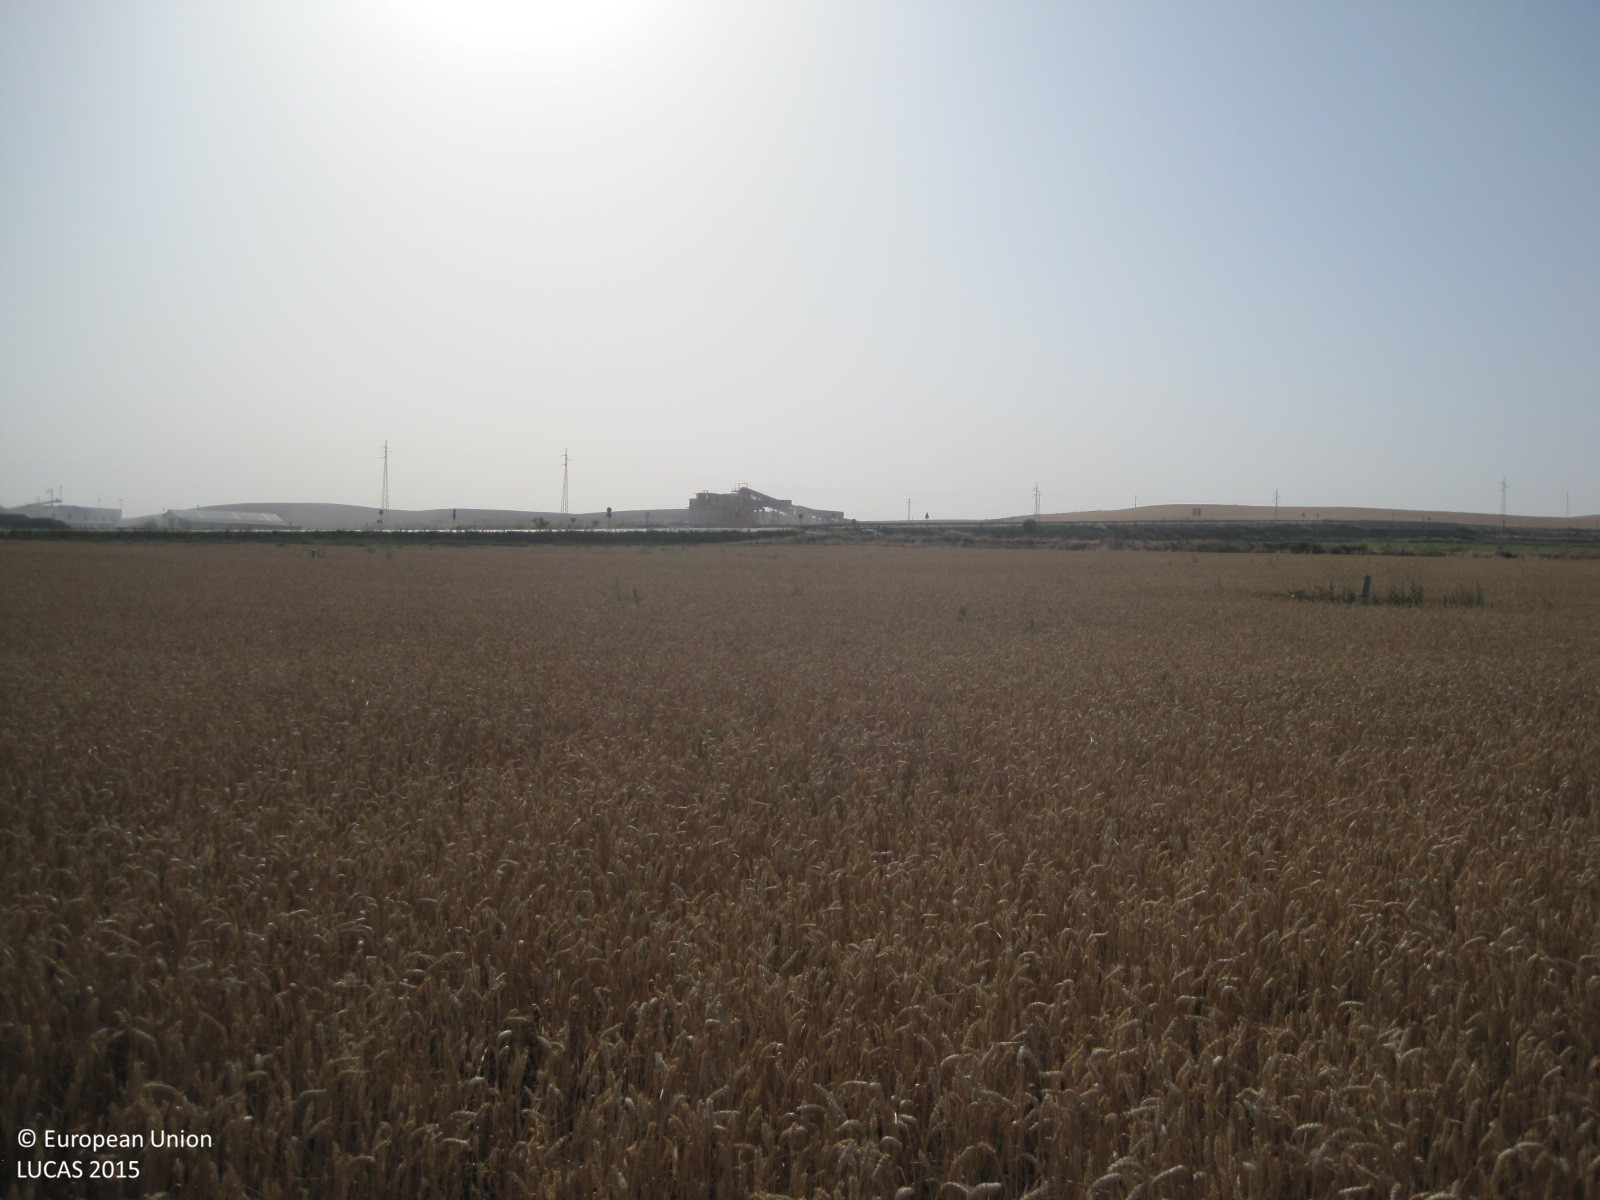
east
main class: Cropland
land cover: Common wheat
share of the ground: > 75 %
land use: Agriculture (excluding fallow land and kitchen gardens)
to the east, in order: Common wheat
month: July
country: ES
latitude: 39.9553
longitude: -3.7392
